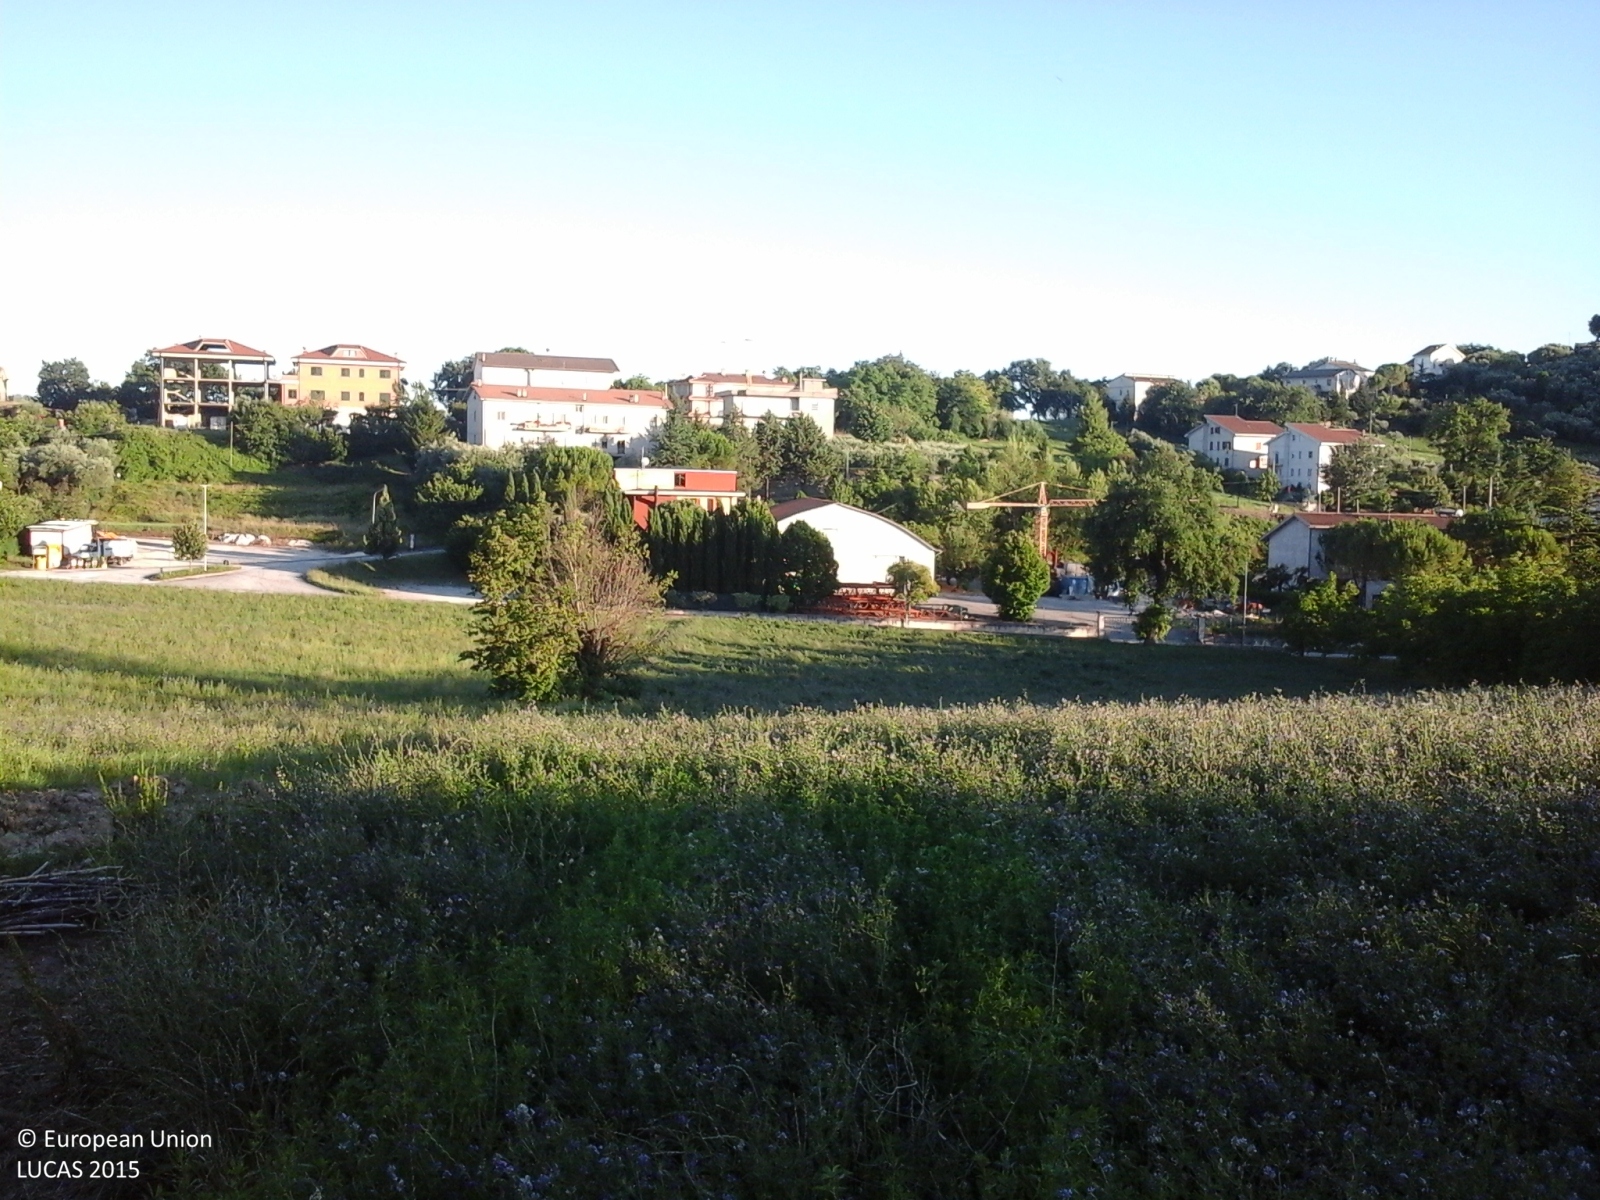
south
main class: Cropland
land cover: Lucerne
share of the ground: > 75 %
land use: Agriculture (excluding fallow land and kitchen gardens)
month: June
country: IT
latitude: 43.2269
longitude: 13.4753
